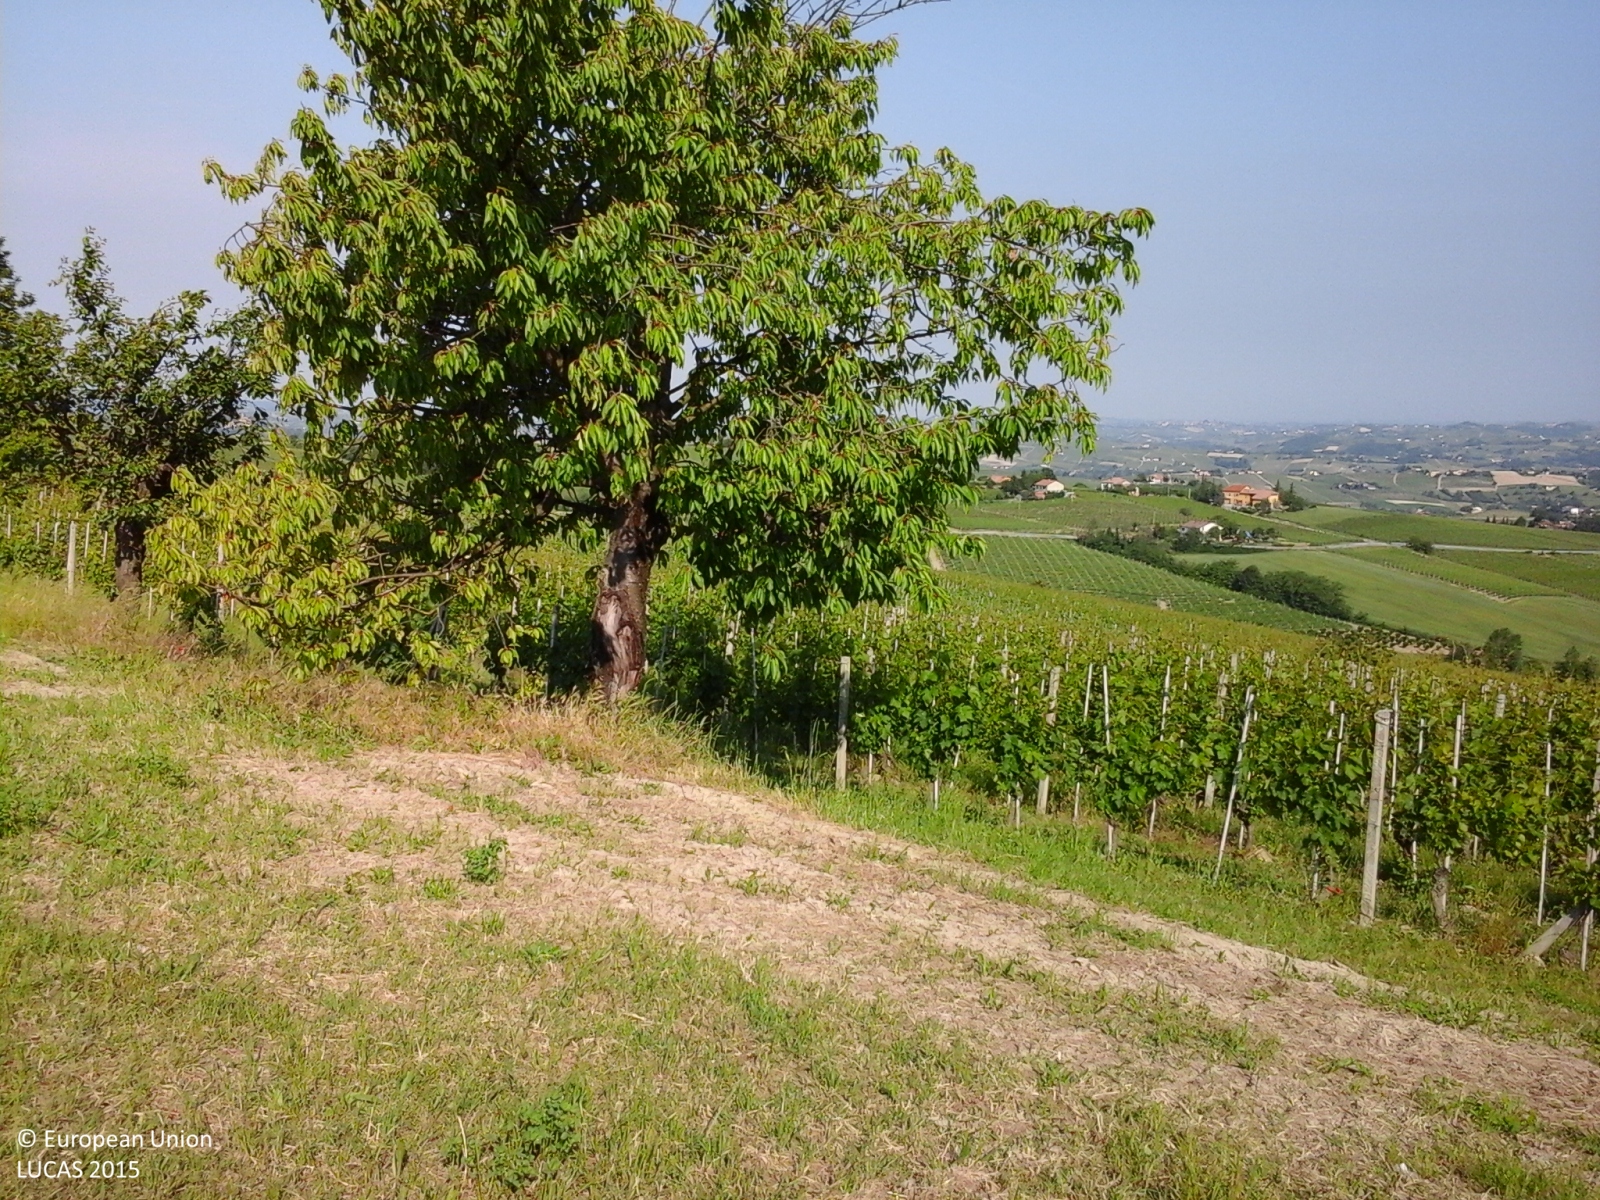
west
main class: Grassland
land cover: Grassland without tree/shrub cover
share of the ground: > 75 %
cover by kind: herbaceous plants 100 %
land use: Agriculture (excluding fallow land and kitchen gardens)
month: May
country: IT
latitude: 44.7350
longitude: 8.3995
